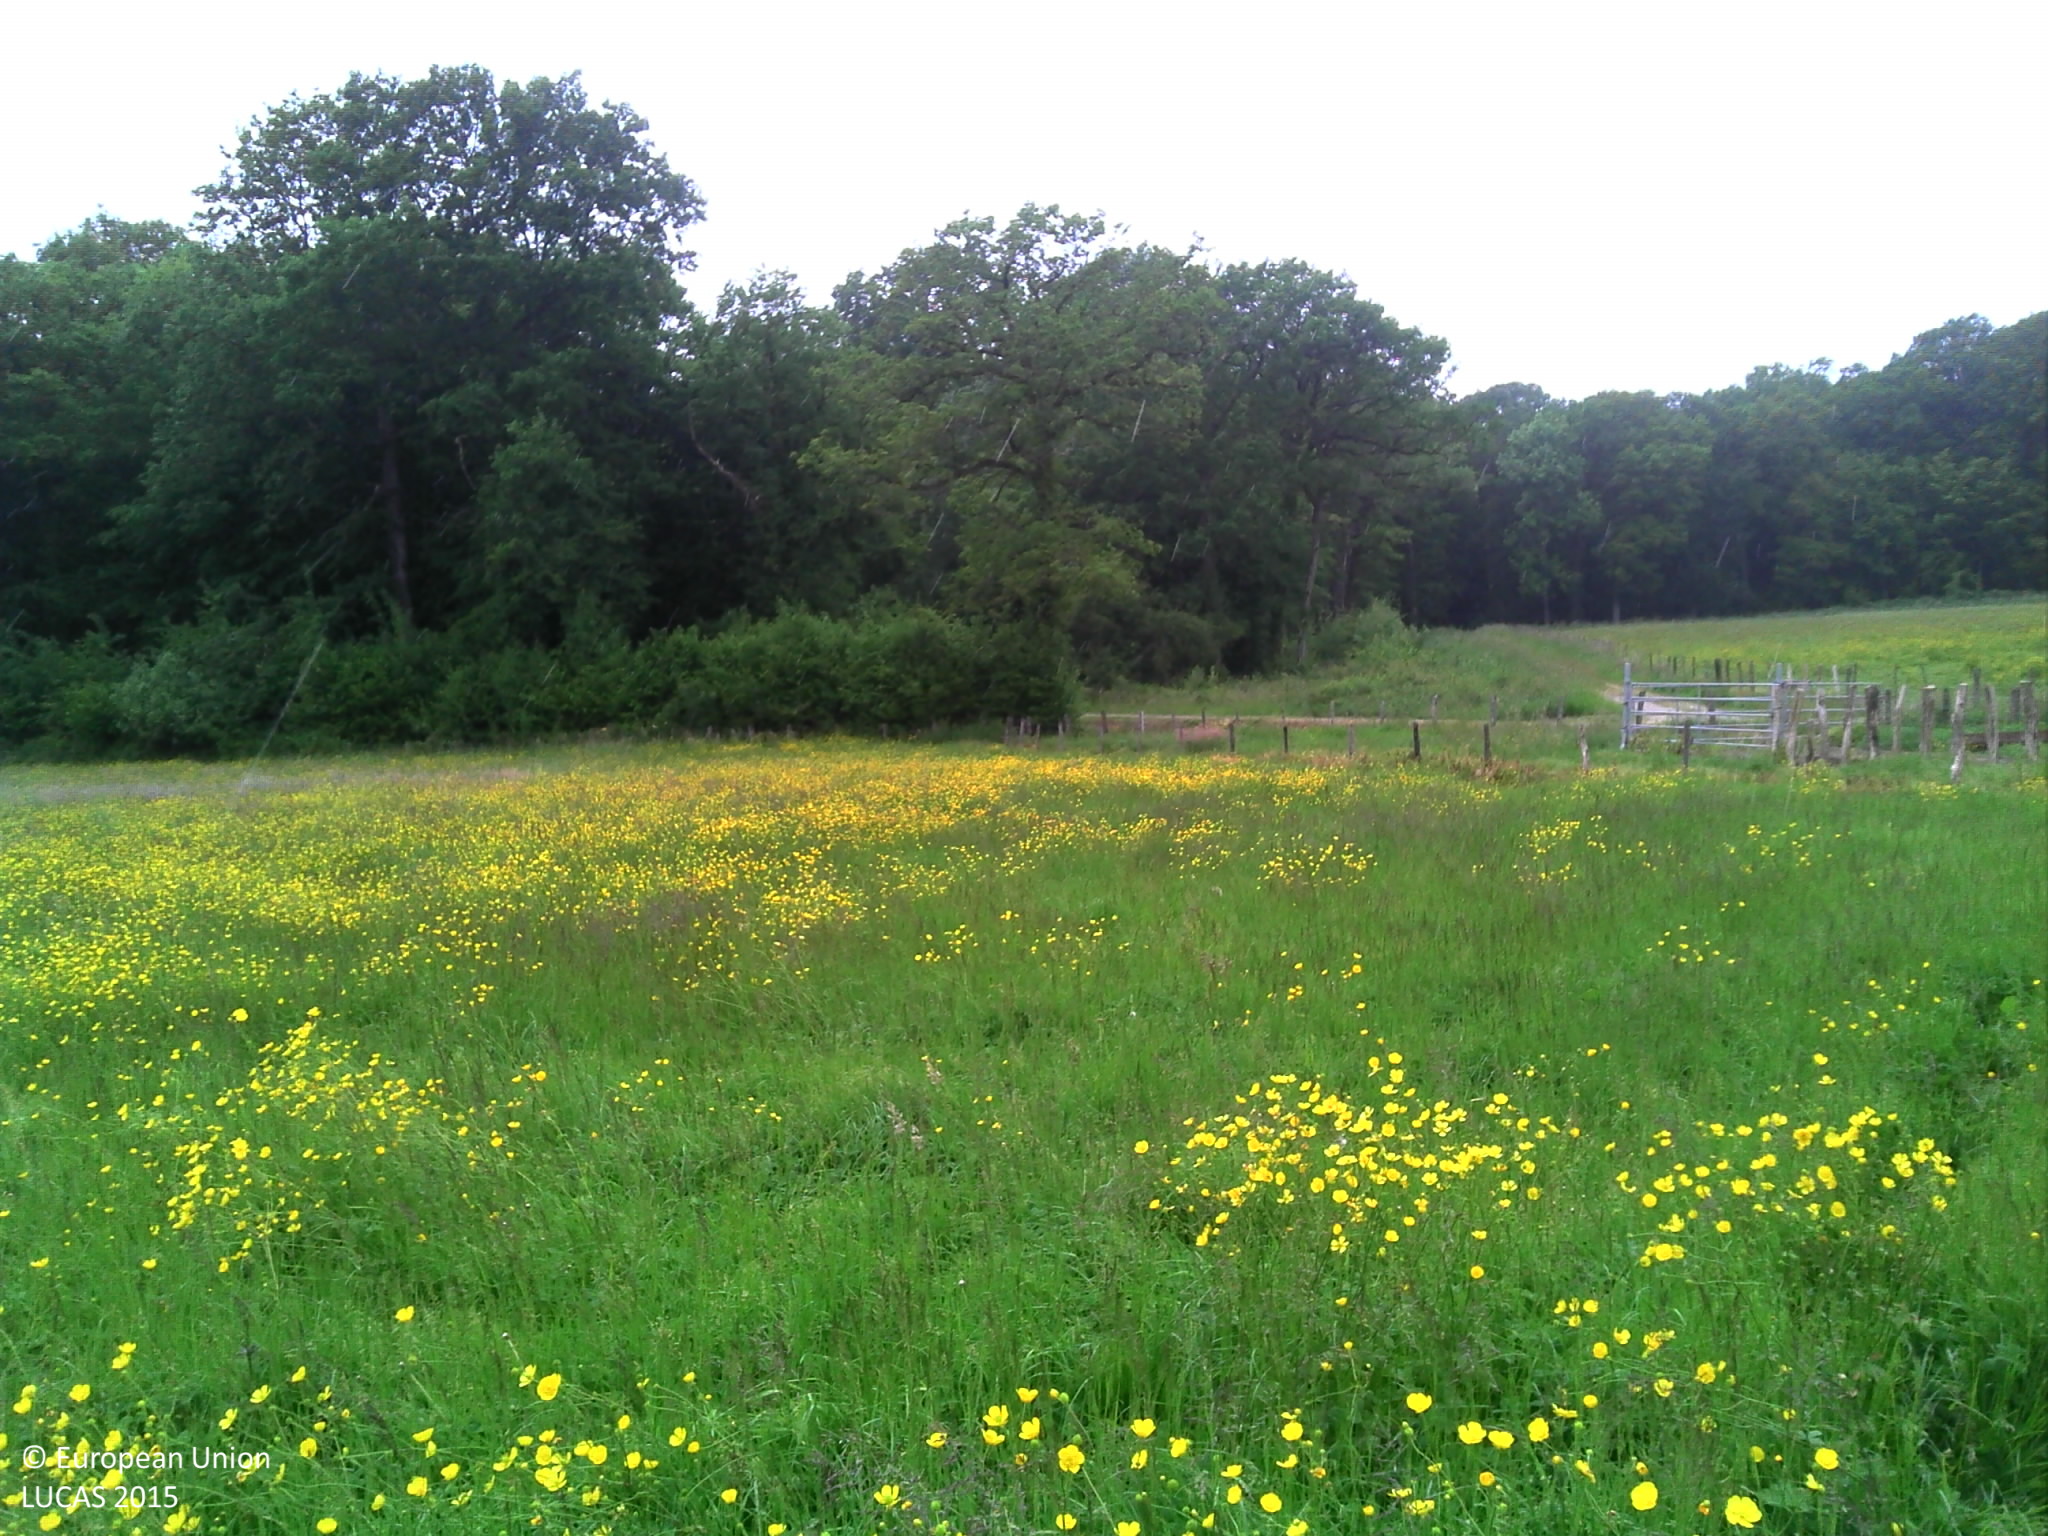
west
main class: Grassland
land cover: Grassland without tree/shrub cover
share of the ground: > 75 %
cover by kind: herbaceous plants 100 %
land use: Agriculture (excluding fallow land and kitchen gardens)
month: May
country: FR
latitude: 47.7920
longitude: 6.0362
